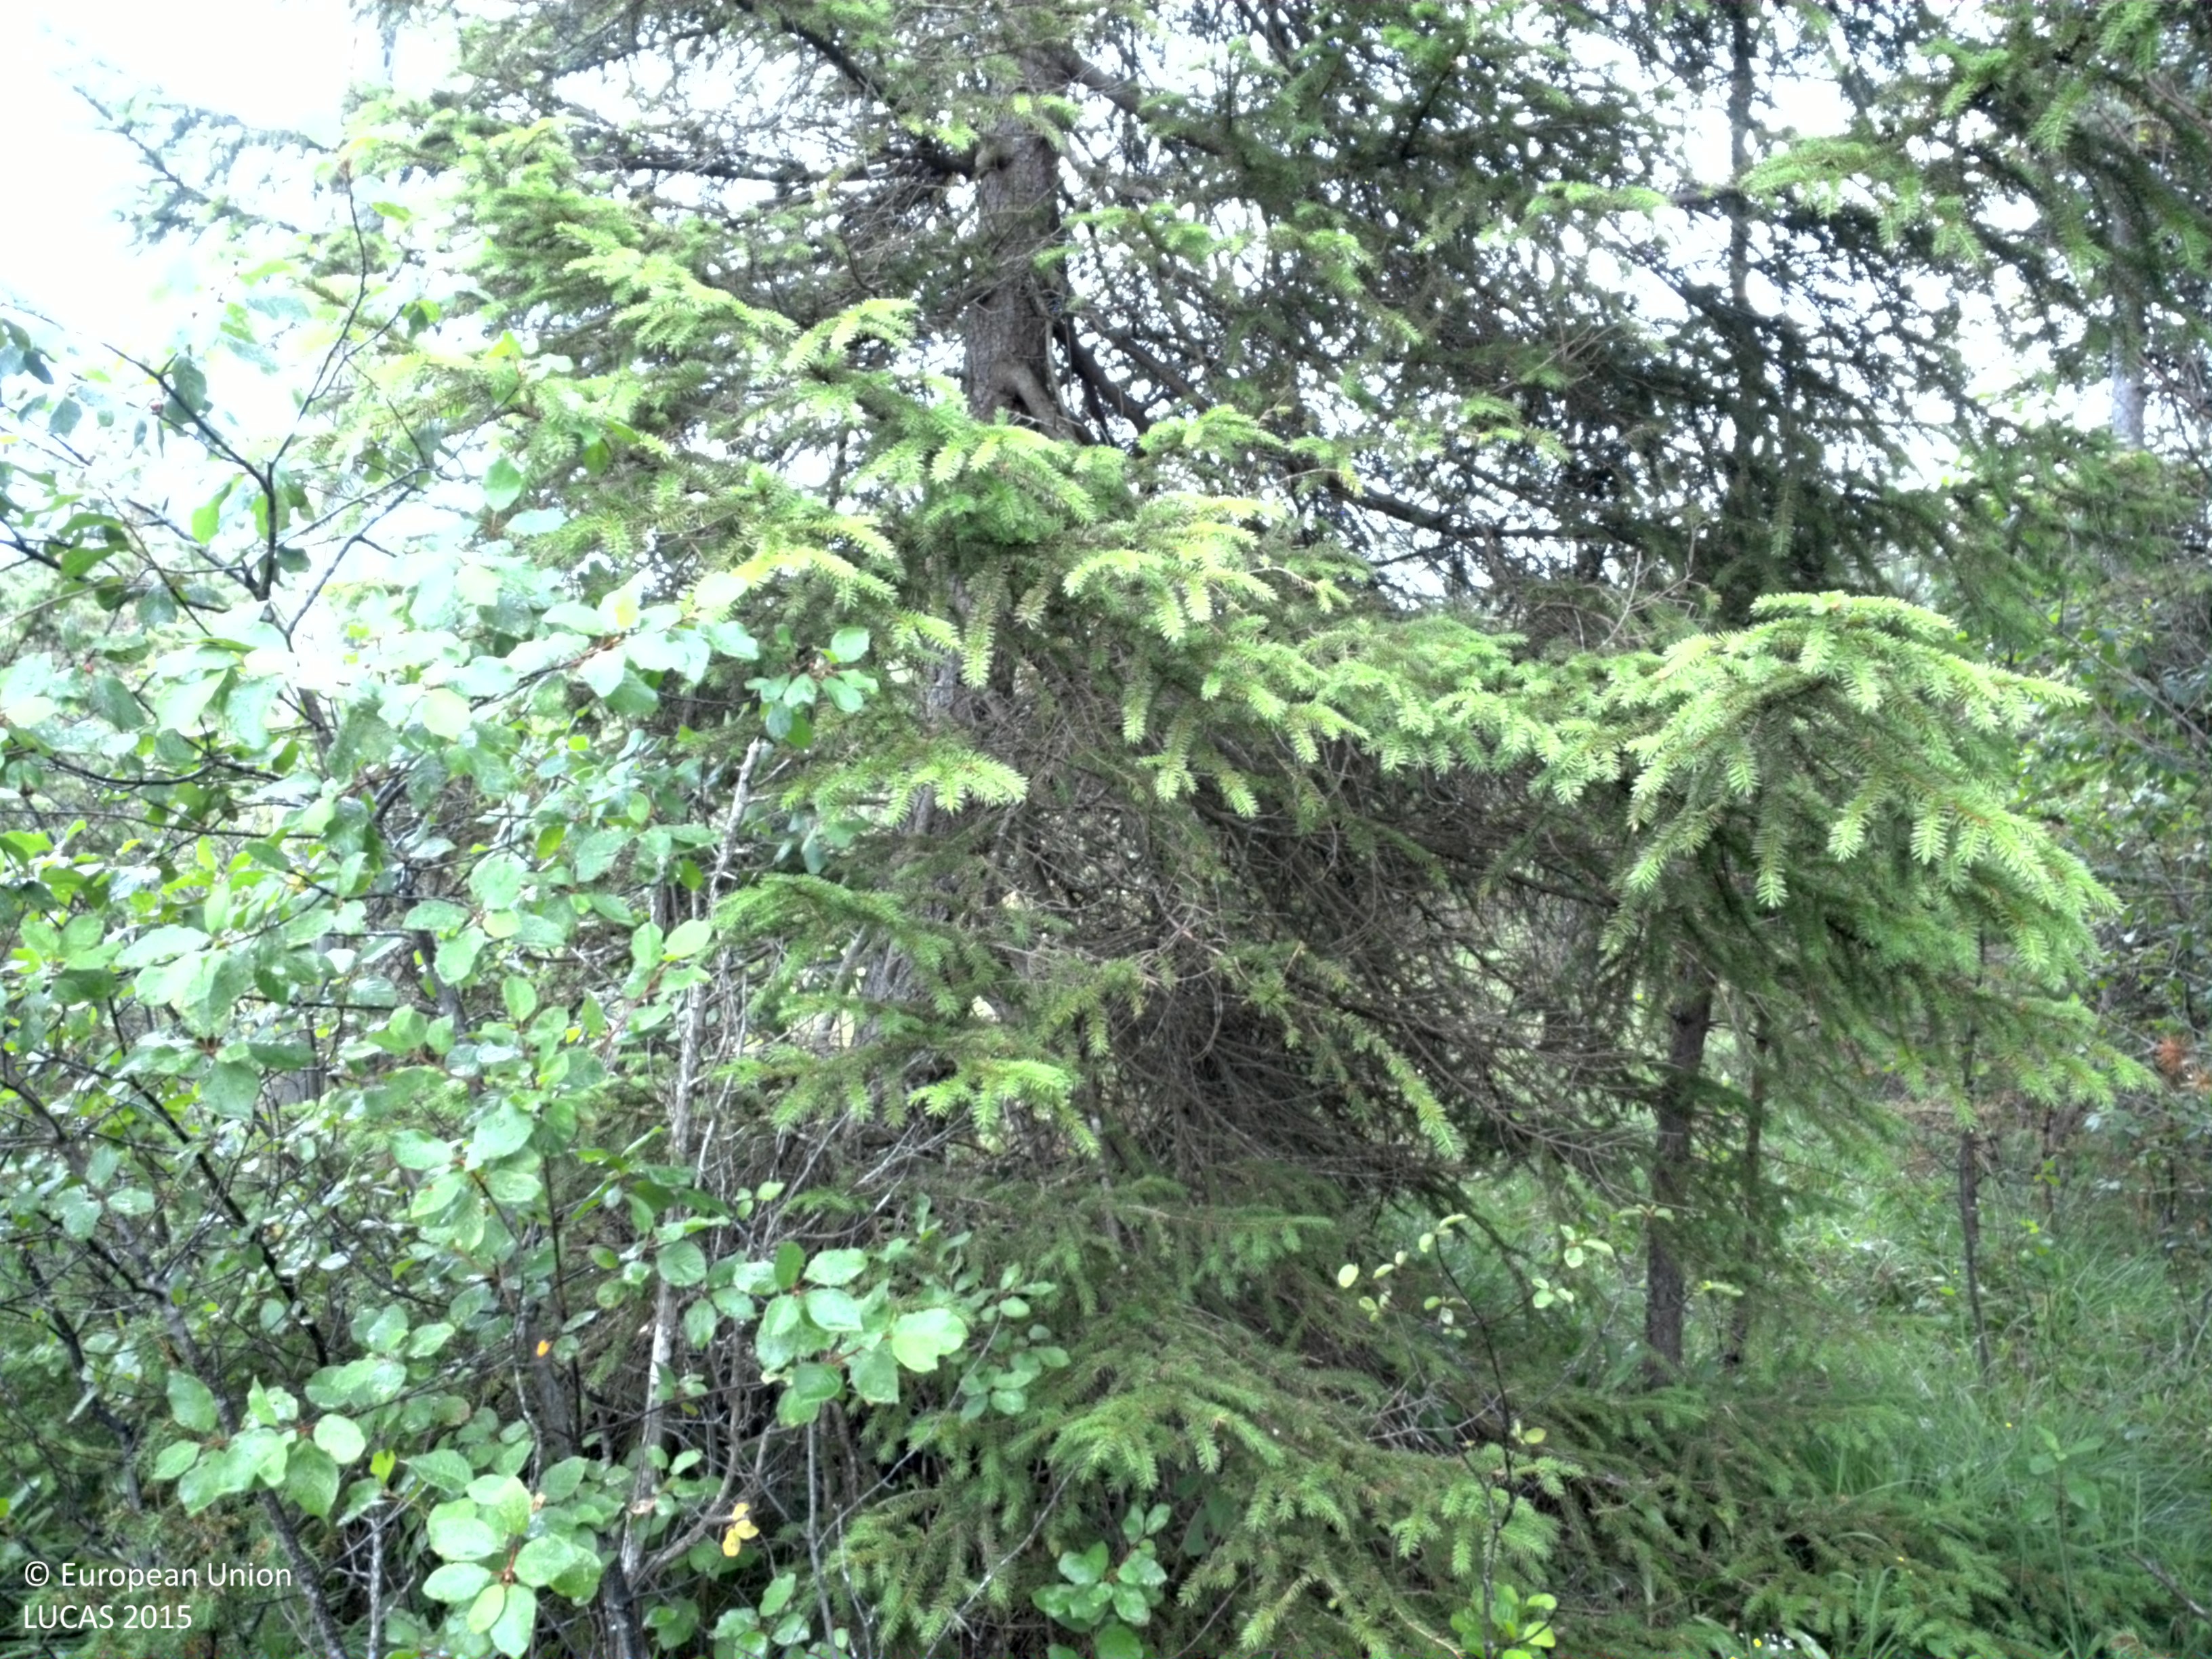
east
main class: Woodland
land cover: Pine dominated coniferous woodland
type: hemiboreal forest and nemoral coniferous forest and mixed broadleaved-coniferous forest
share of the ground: > 75 %
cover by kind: coniferous forest trees 60 %, herbaceous plants 20 %, shrubs 15 %, broadleaved forest trees 5 %
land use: Forestry
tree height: < 5 m
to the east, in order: Pine dominated coniferous woodland; Electric lines; Pine dominated coniferous woodland
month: July
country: SE
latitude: 57.4867
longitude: 18.6673
